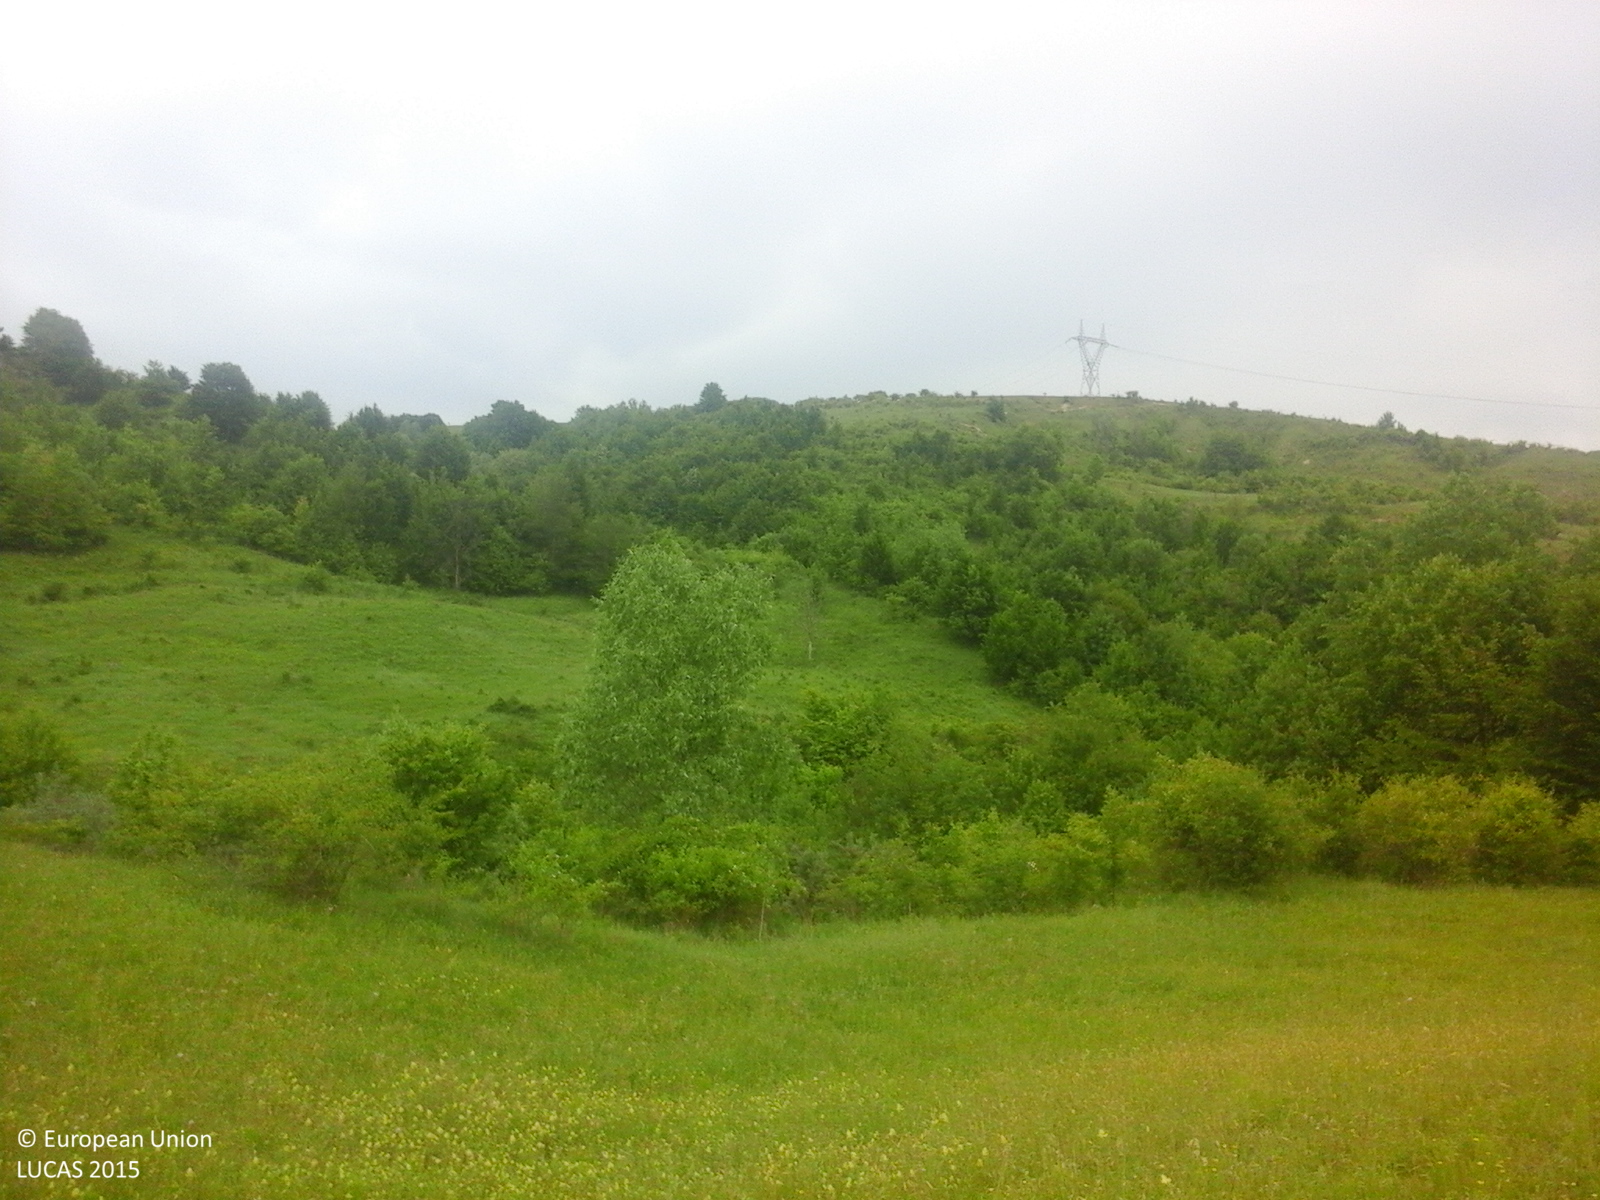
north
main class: Grassland
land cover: Grassland without tree/shrub cover
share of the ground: > 75 %
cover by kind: herbaceous plants 100 %
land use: Agriculture (excluding fallow land and kitchen gardens)
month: June
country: RO
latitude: 46.3486
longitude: 26.7062
